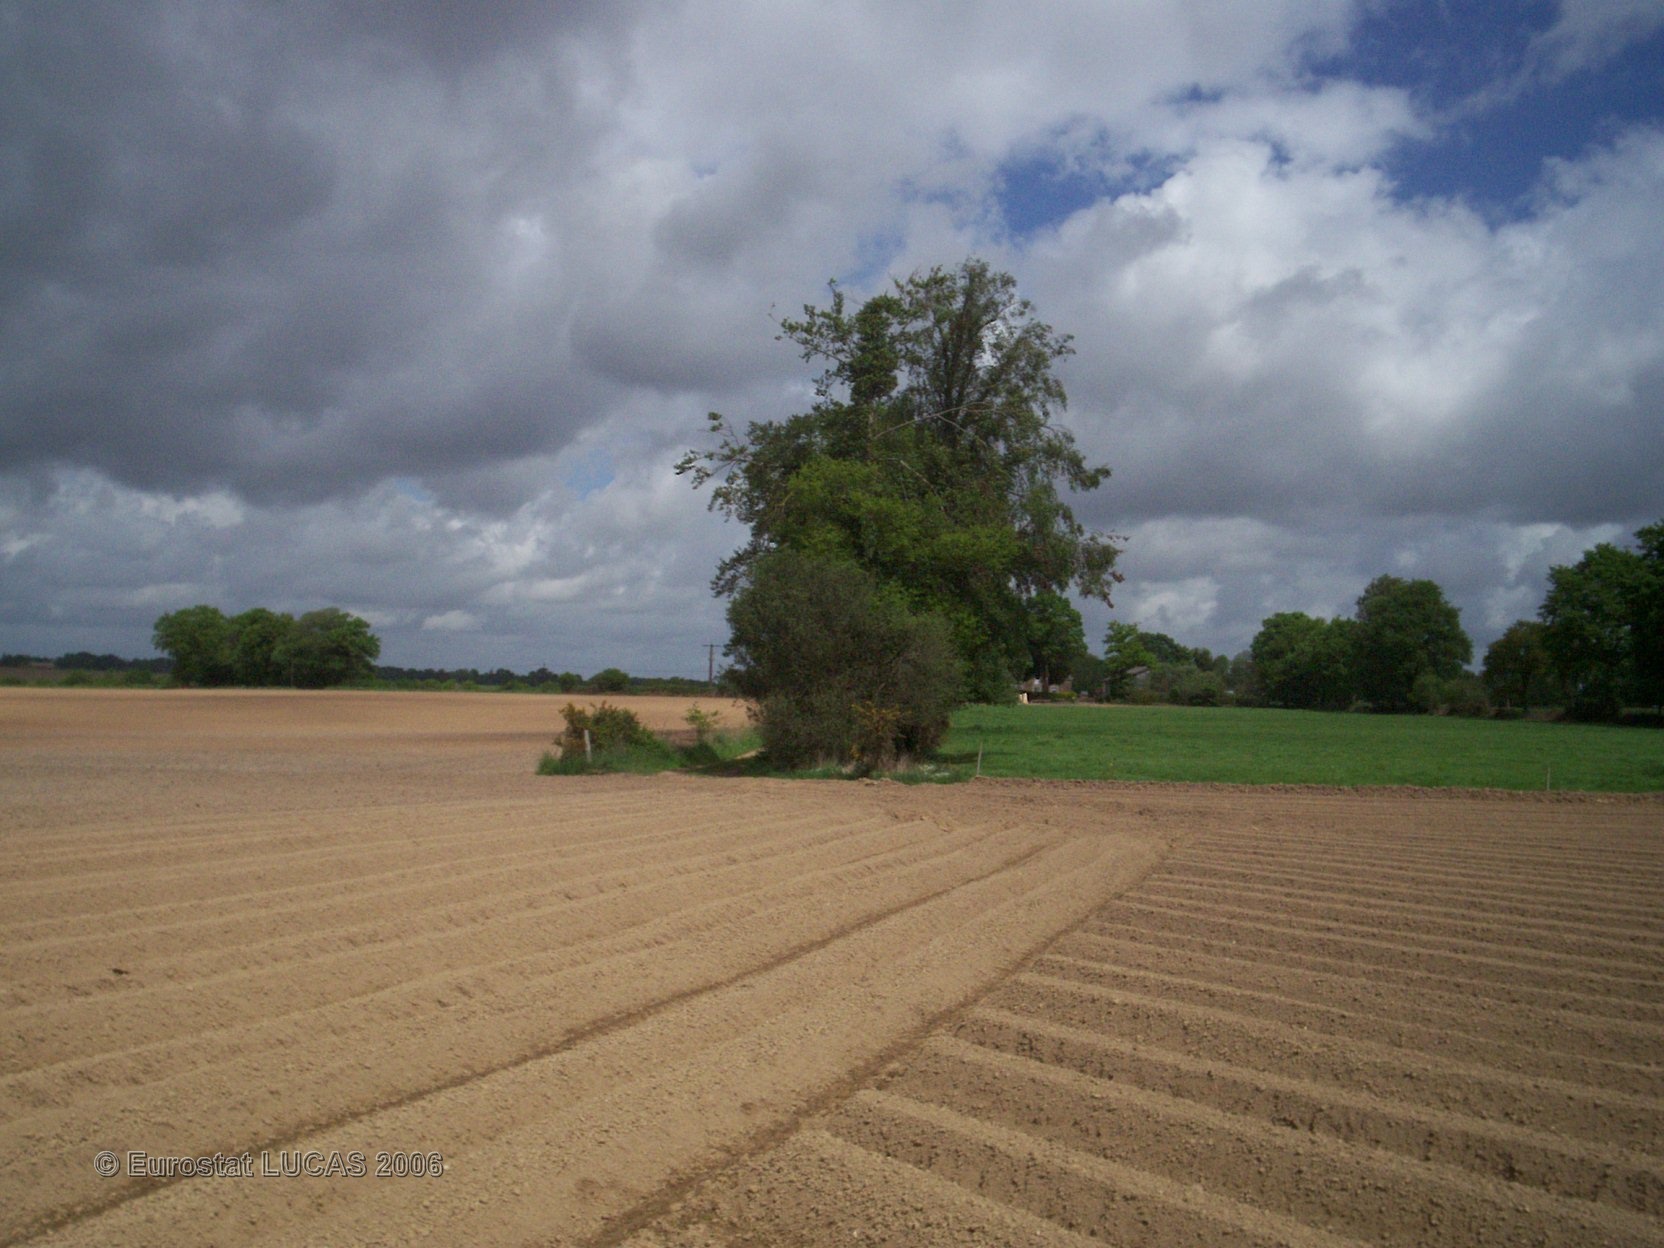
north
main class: Cropland
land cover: Potatoes
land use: Agriculture (excluding fallow land and kitchen gardens)
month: May
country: FR
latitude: 47.9892
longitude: -2.7532
